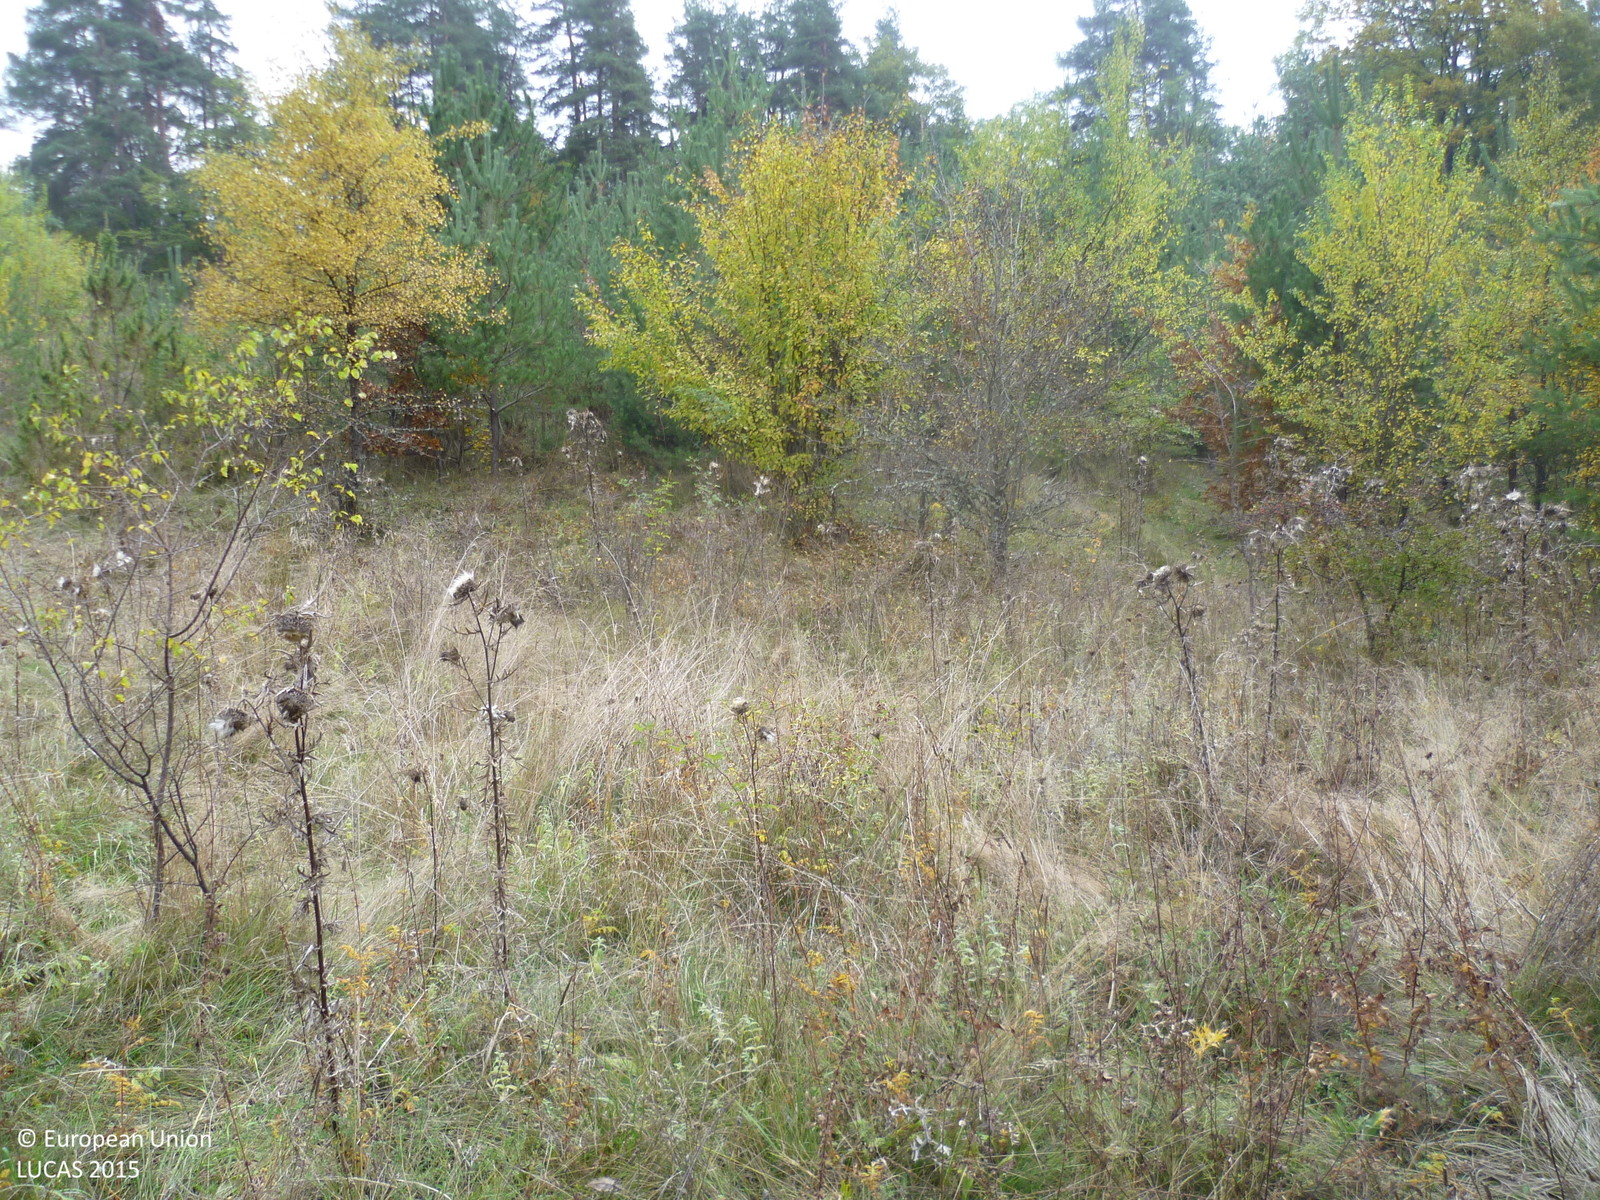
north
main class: Grassland
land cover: Grassland with sparse tree/shrub cover
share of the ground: > 75 %
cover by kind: herbaceous plants 90 %, coniferous forest trees 5 %, shrubs 5 %
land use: Semi-natural and natural areas not in use
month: October
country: BG
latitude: 42.5139
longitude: 23.6323
